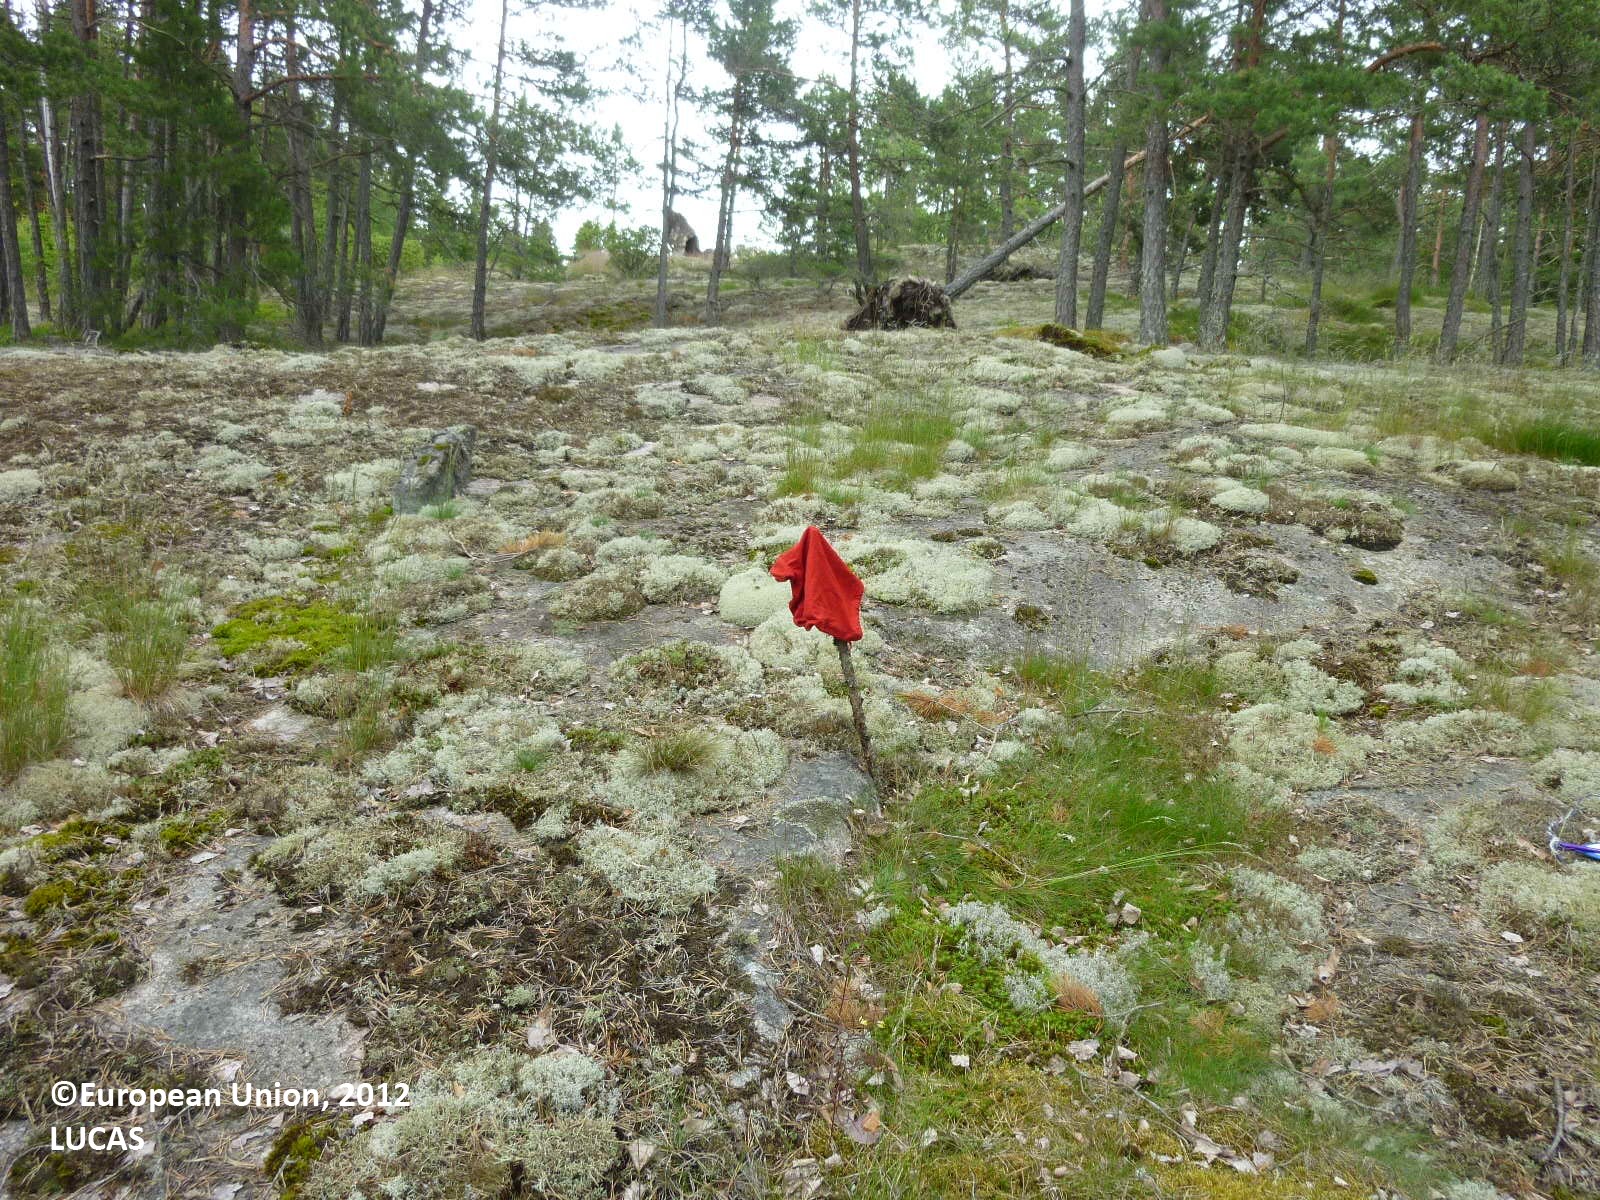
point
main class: Woodland
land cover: Pine dominated coniferous woodland
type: boreal forest
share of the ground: 10 - 25 %
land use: Forestry
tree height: > 5 m
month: June
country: FI
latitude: 60.2798
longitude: 22.4946
